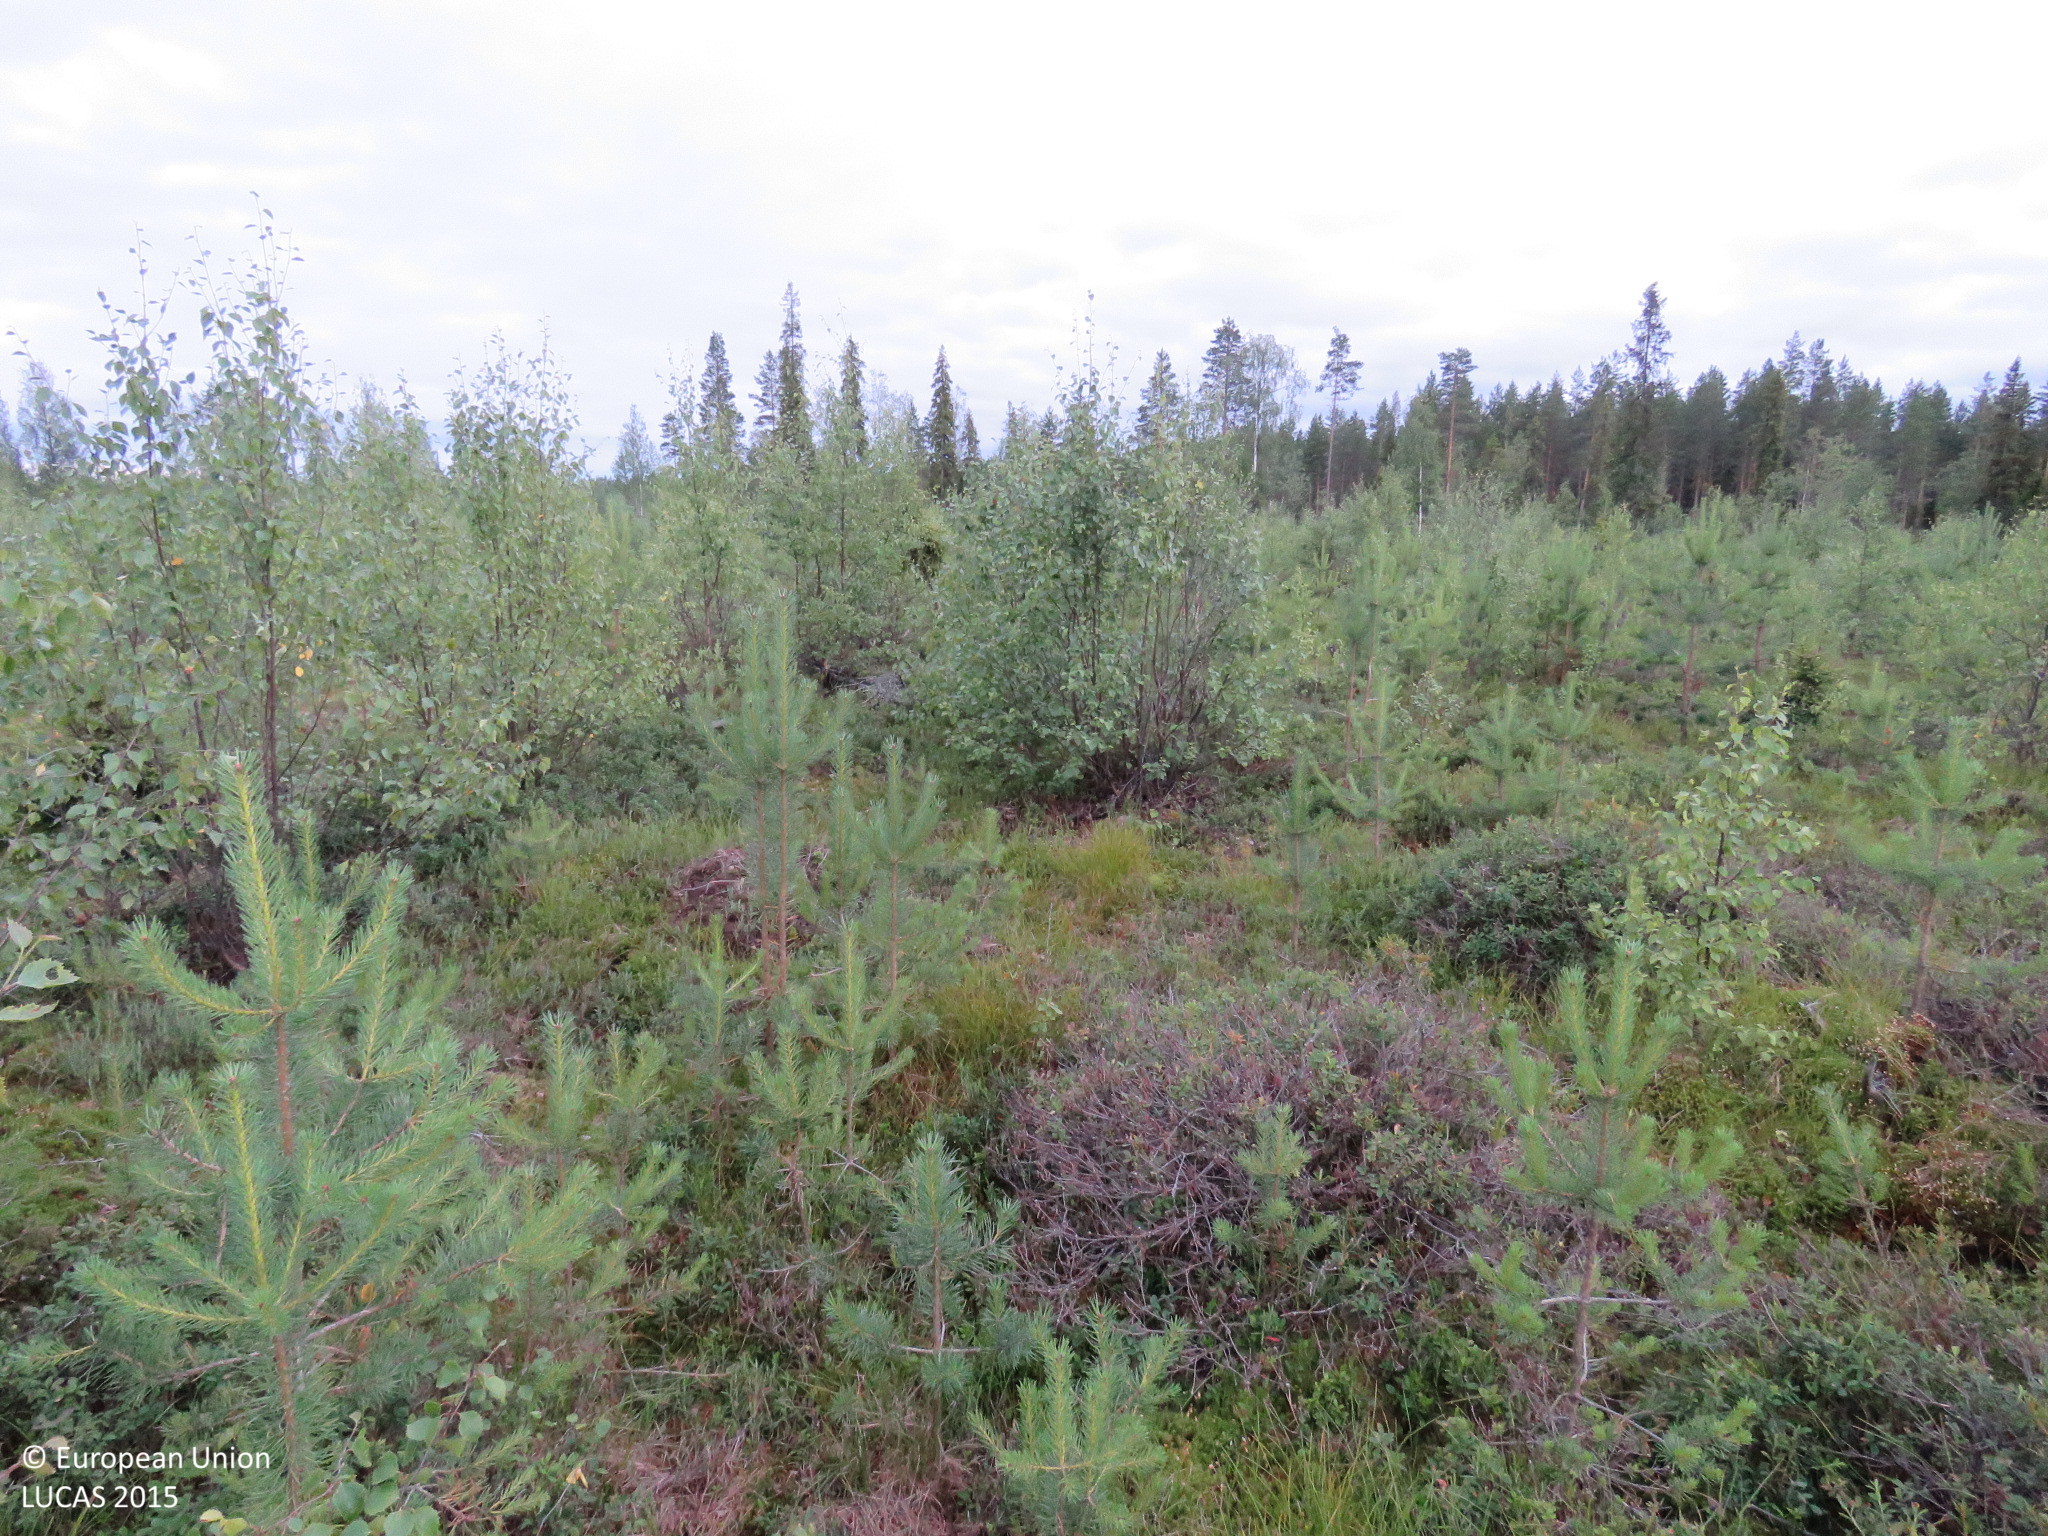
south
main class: Woodland
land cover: Pine dominated mixed woodland
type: boreal forest
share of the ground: 50 - 75 %
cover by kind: coniferous forest trees 30 %, broadleaved forest trees 30 %, shrubs 20 %, lichens and mosses 15 %, herbaceous plants 5 %
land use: Forestry
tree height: < 5 m
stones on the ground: < 10 %
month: July
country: FI
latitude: 64.6865
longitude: 26.5687
